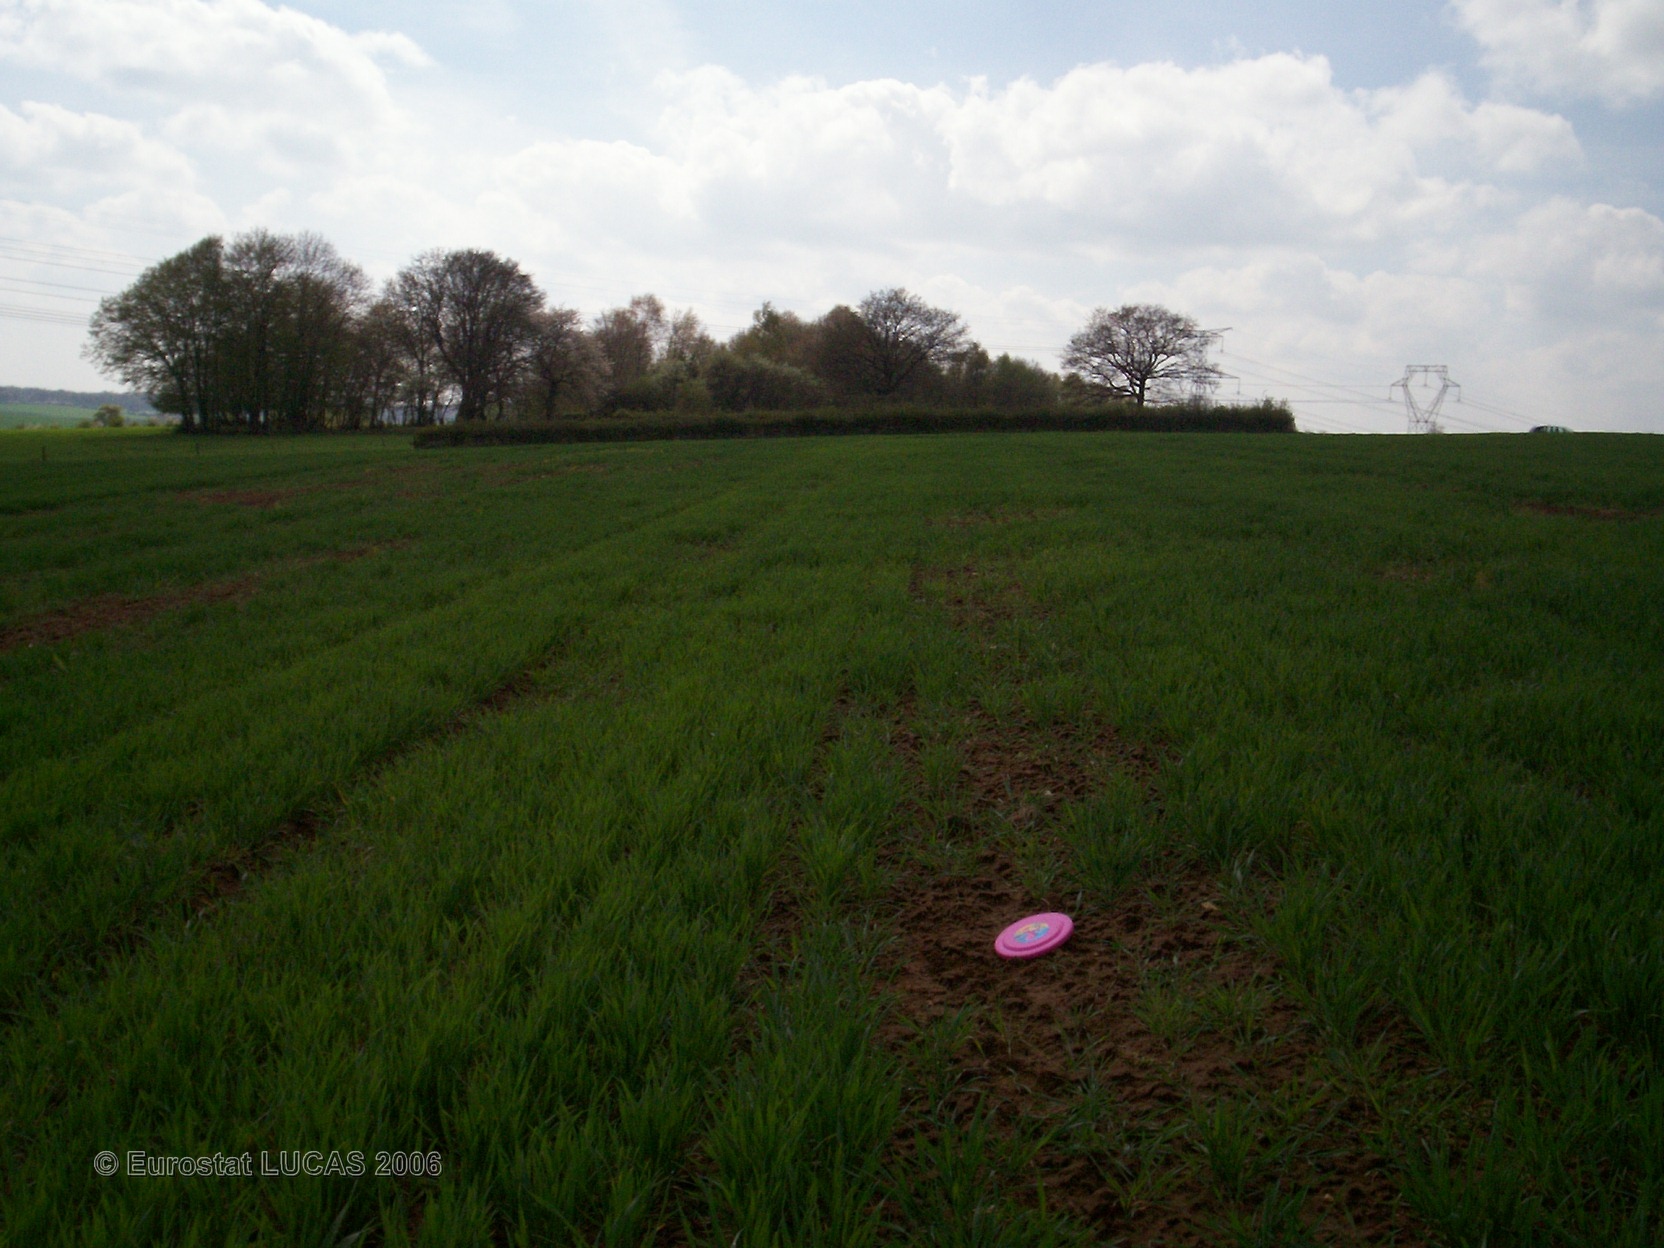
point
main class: Cropland
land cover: Common wheat
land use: Agriculture (excluding fallow land and kitchen gardens)
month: May
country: FR
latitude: 49.8107
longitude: 4.3676
